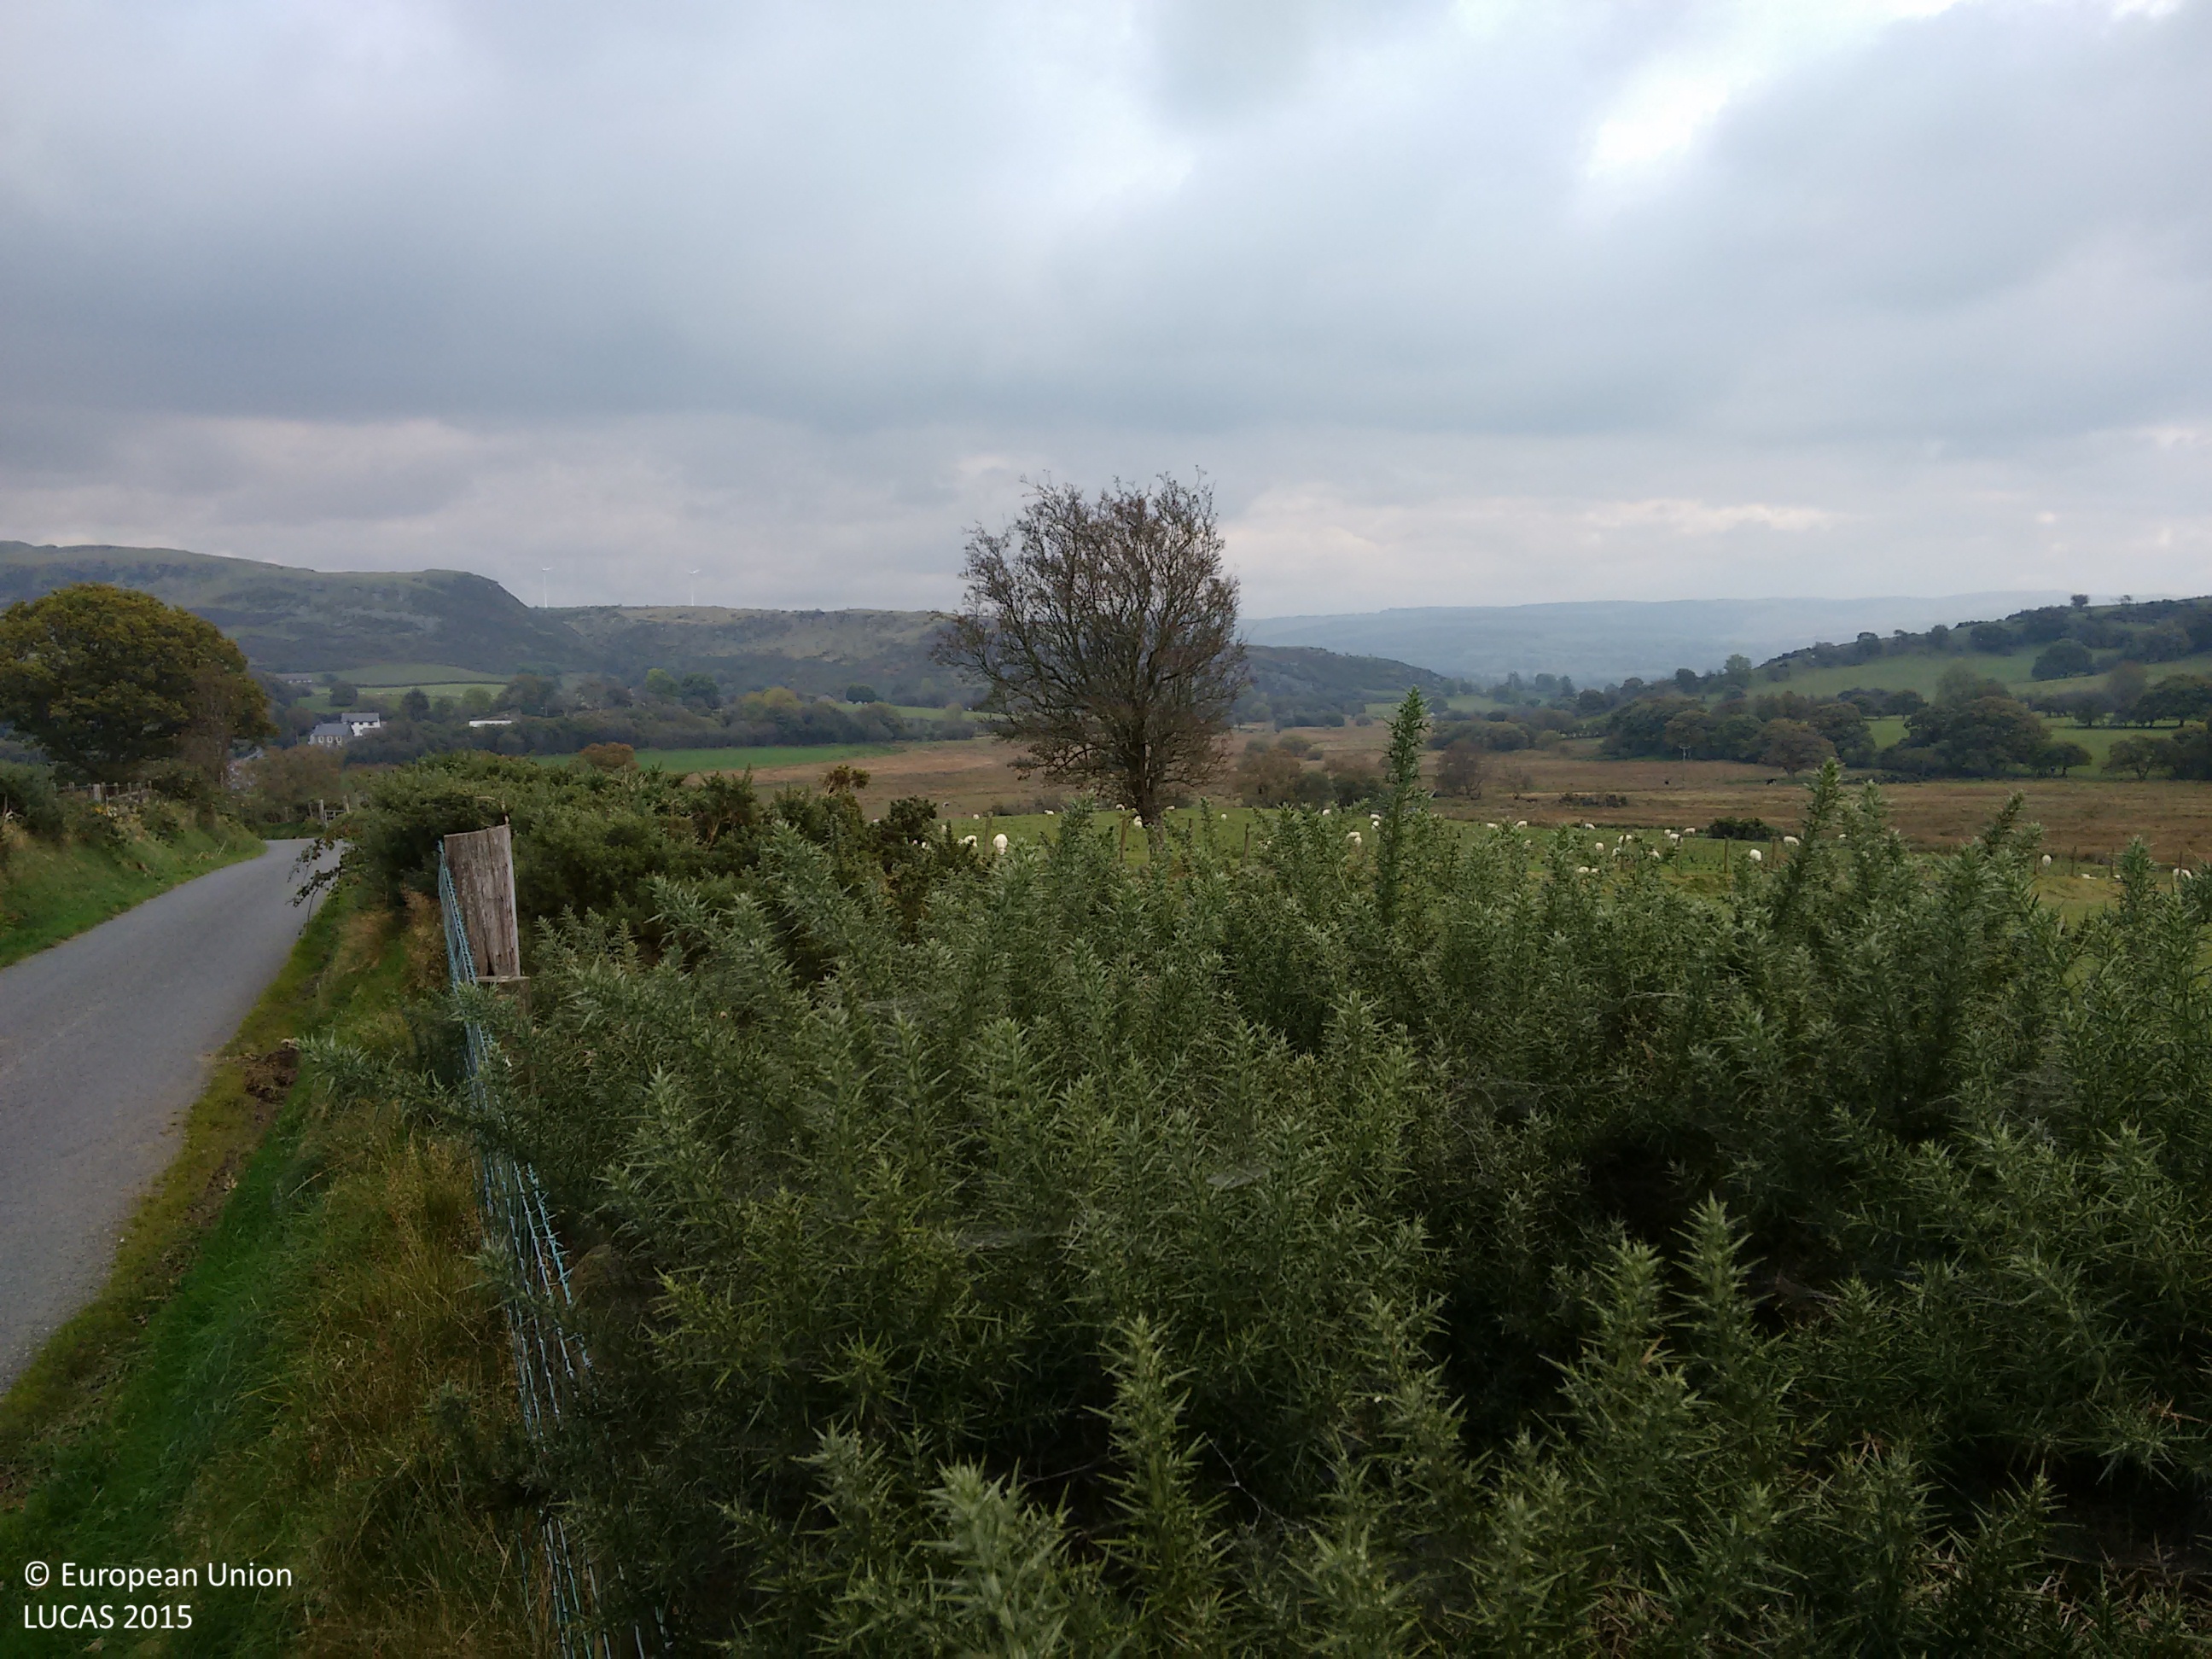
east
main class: Grassland
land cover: Grassland without tree/shrub cover
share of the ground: > 75 %
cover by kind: herbaceous plants 100 %
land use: Agriculture (excluding fallow land and kitchen gardens)
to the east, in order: Grassland without tree/shrub cover; Fences; Grassland without tree/shrub cover; Electric lines; Grassland without tree/shrub cover; Fences; Abandoned hedges
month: October
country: GB
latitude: 52.3003
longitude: -3.9214
